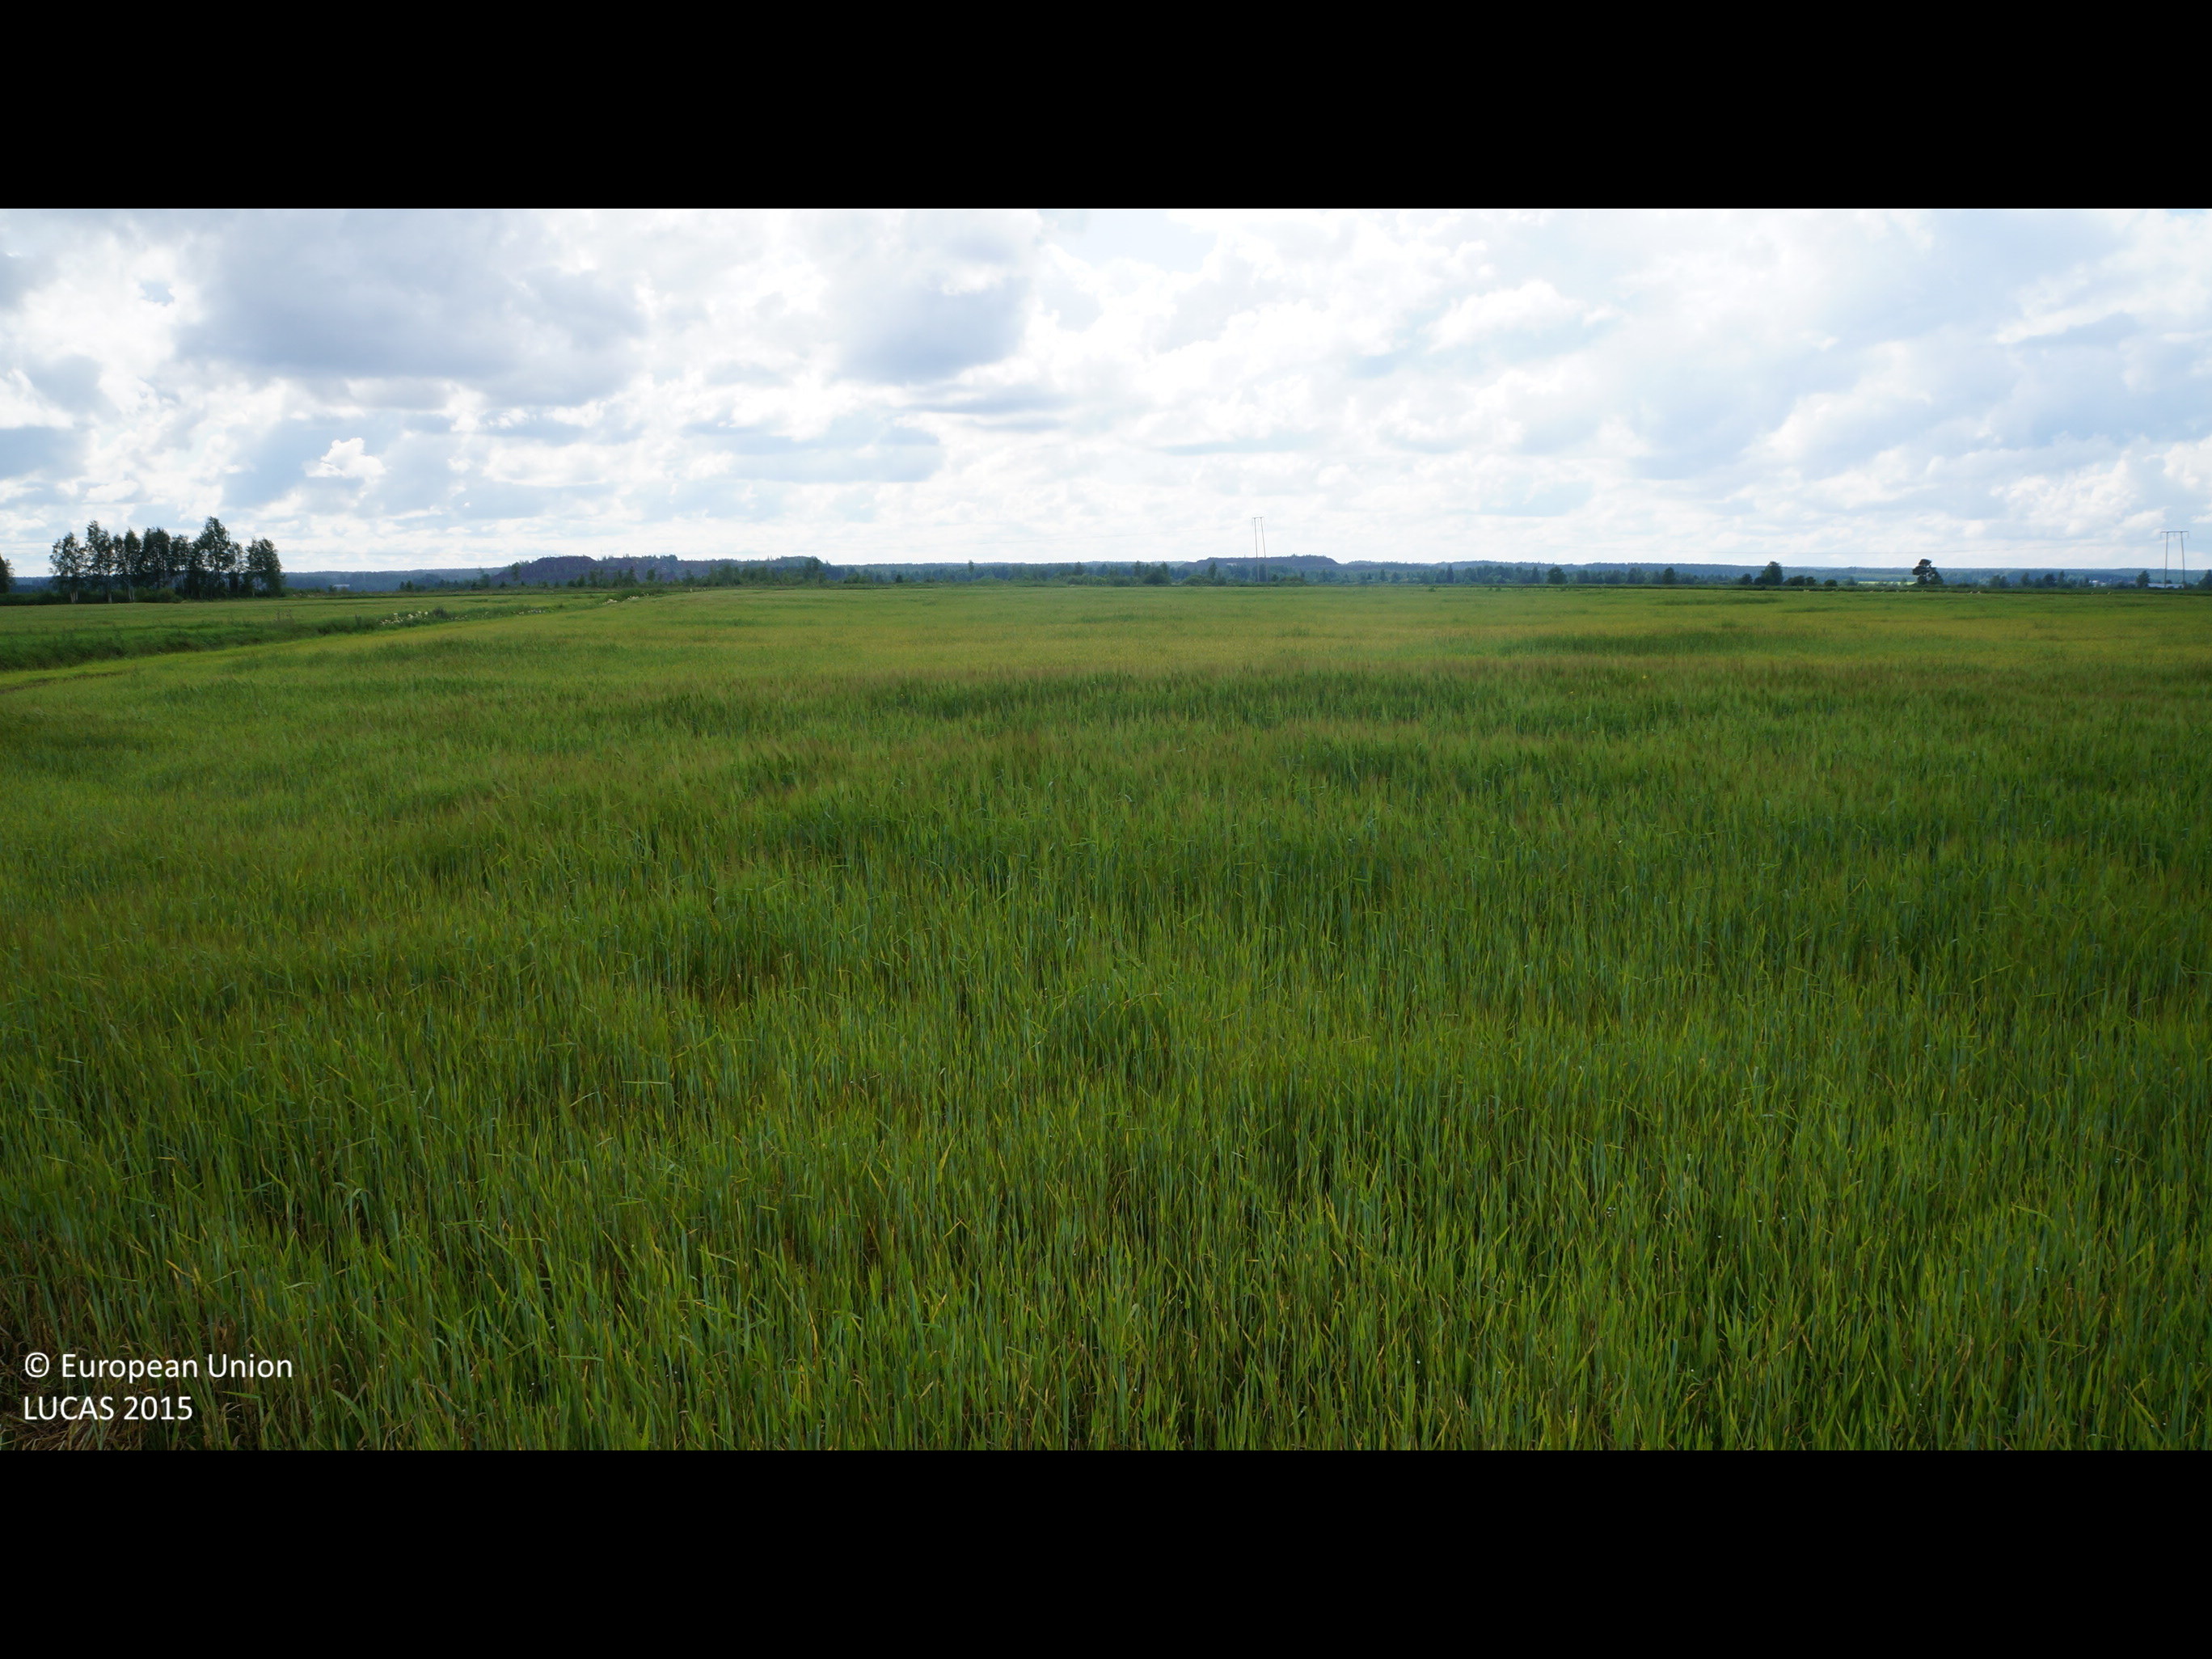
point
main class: Cropland
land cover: Barley
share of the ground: > 75 %
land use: Agriculture (excluding fallow land and kitchen gardens)
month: July
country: FI
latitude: 63.8562
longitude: 25.0797
